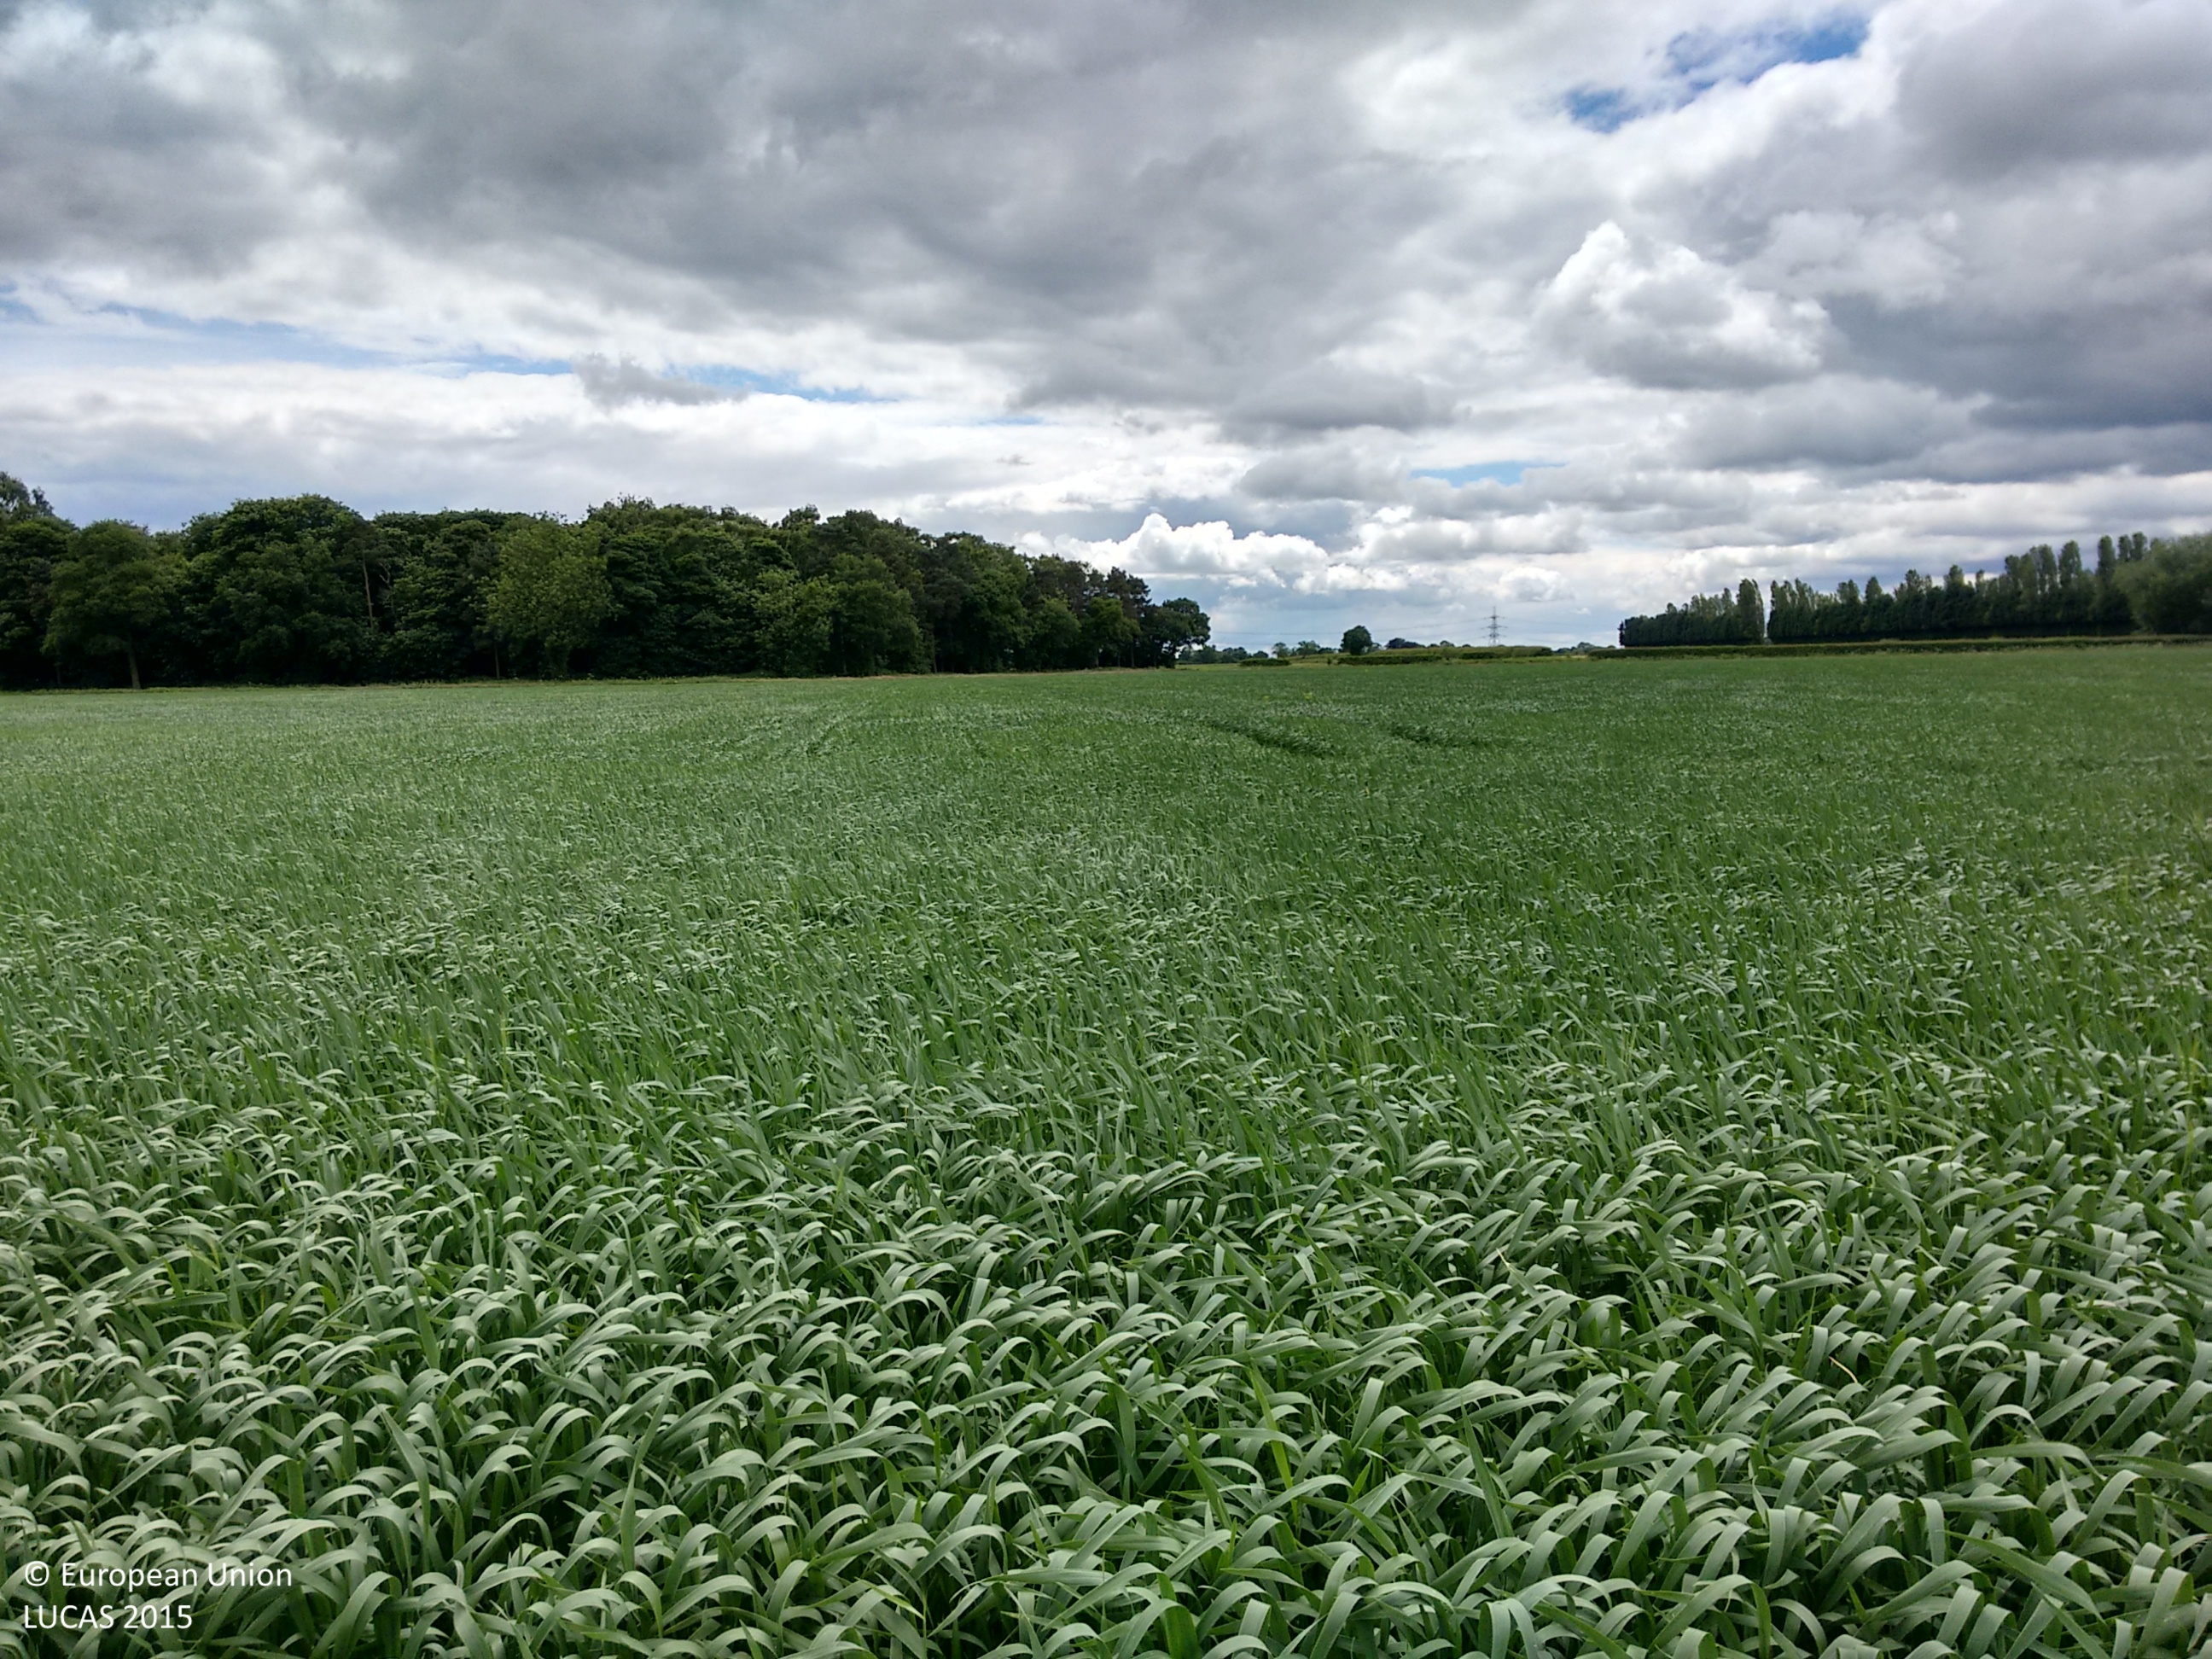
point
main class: Cropland
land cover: Common wheat
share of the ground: > 75 %
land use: Agriculture (excluding fallow land and kitchen gardens)
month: June
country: GB
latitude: 53.7461
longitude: -1.0678
